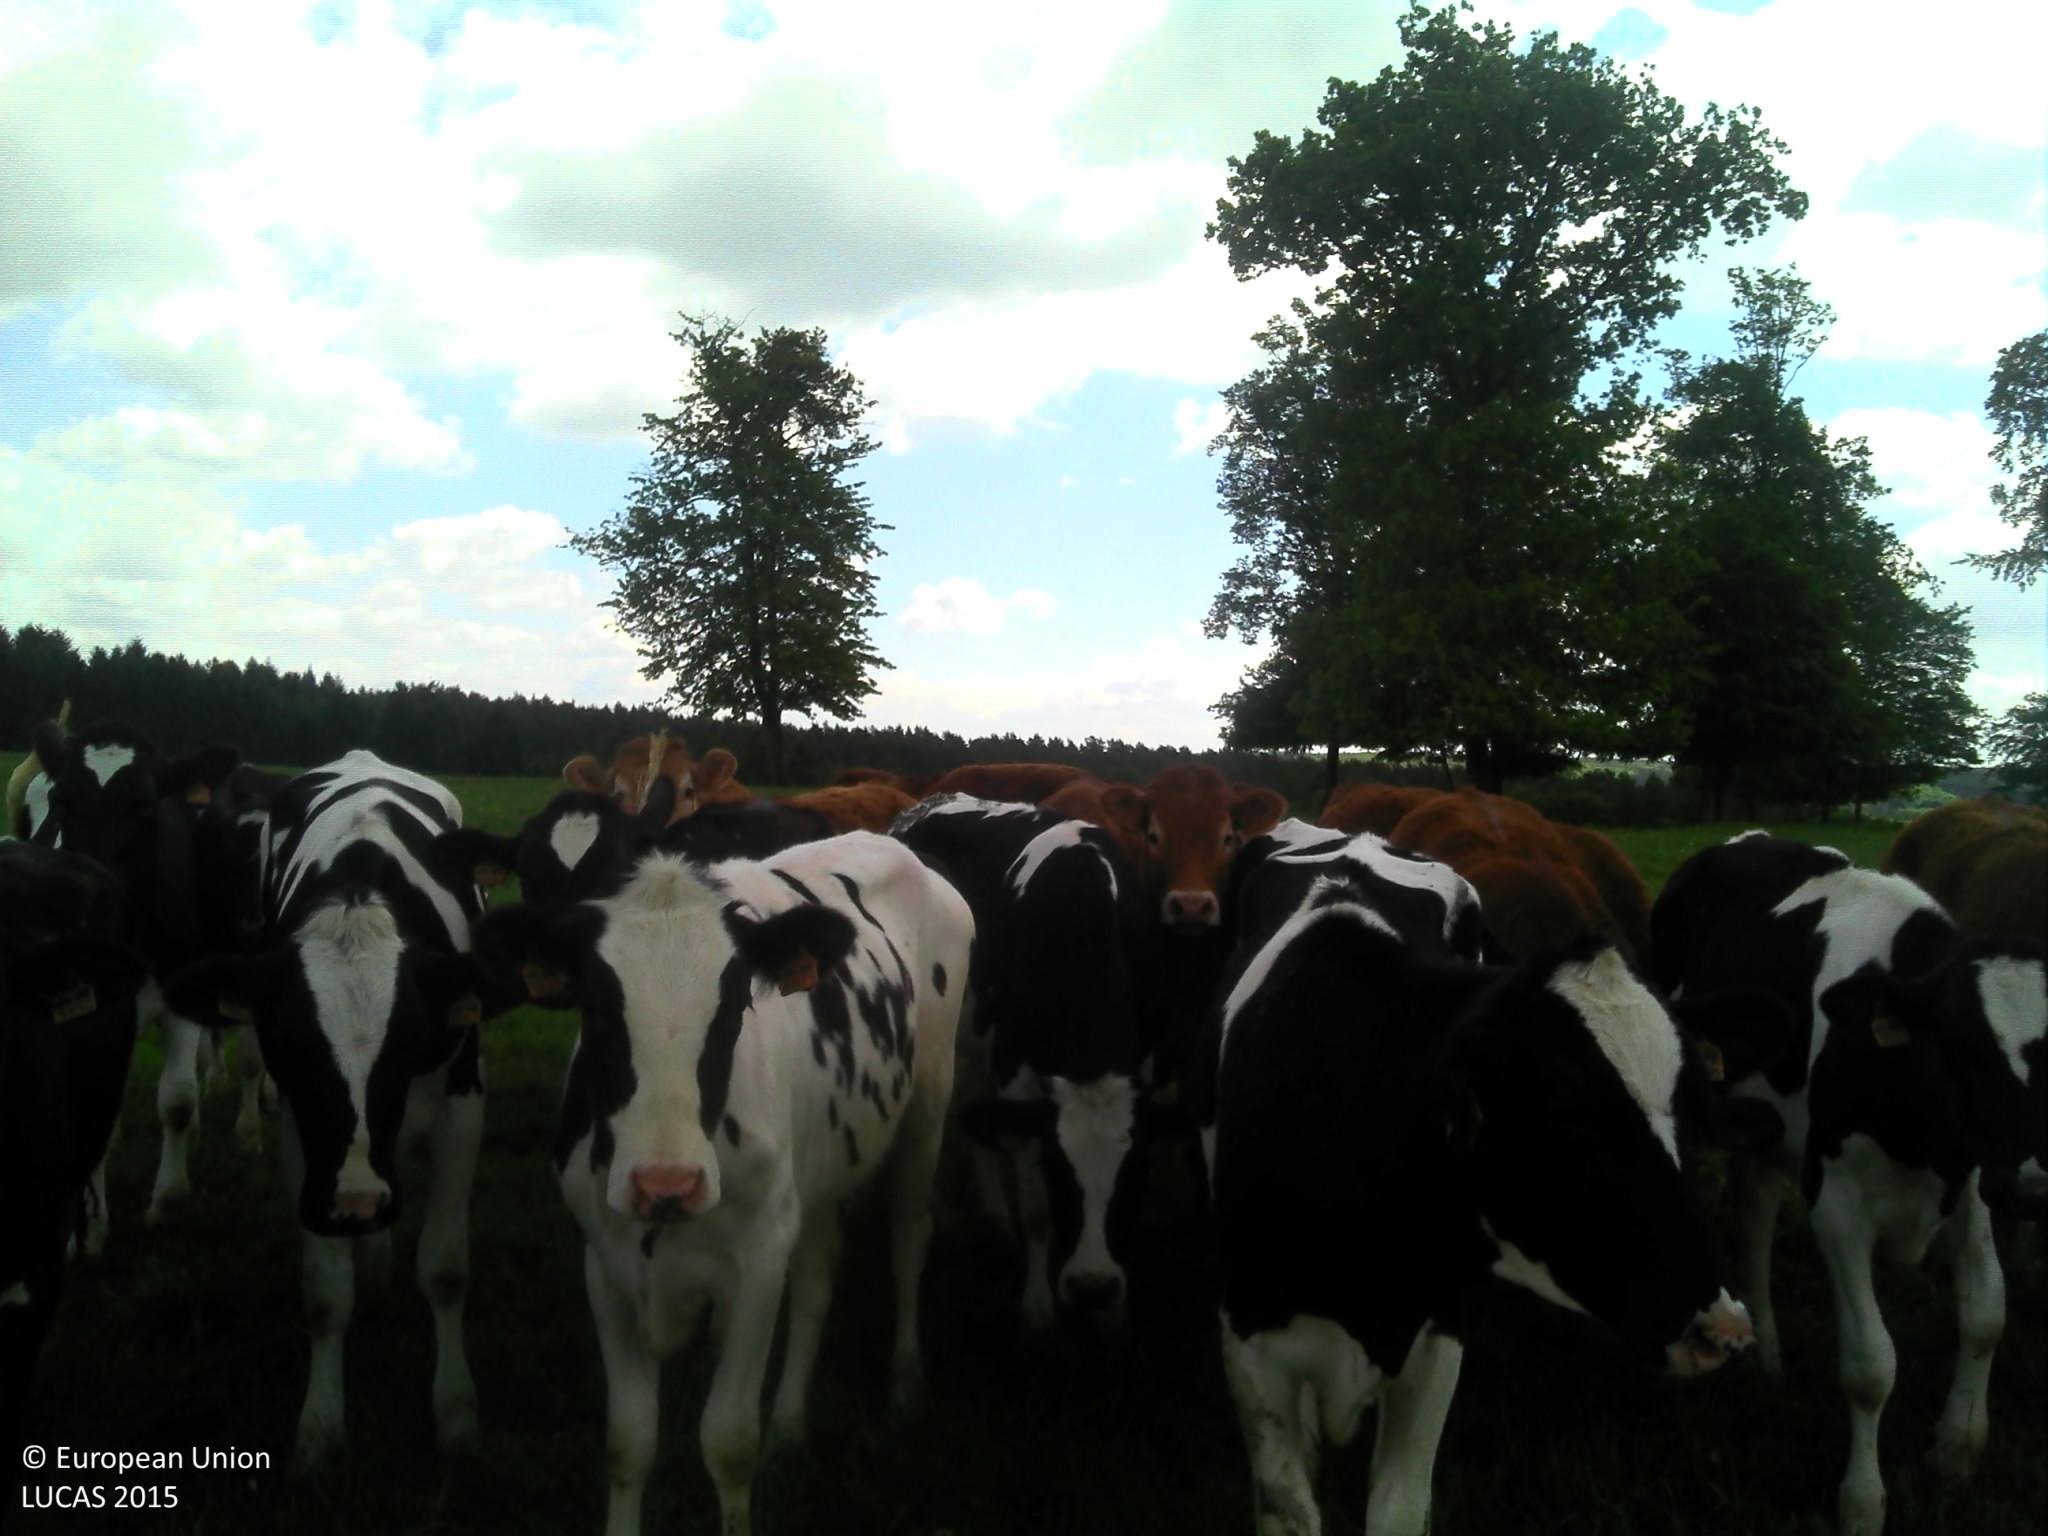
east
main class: Grassland
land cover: Grassland without tree/shrub cover
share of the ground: > 75 %
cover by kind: herbaceous plants 100 %
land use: Agriculture (excluding fallow land and kitchen gardens)
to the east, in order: Grassland without tree/shrub cover; Single bushes/trees; Grassland without tree/shrub cover; Fences; Triticale
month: May
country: LU
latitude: 49.8026
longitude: 6.3733
